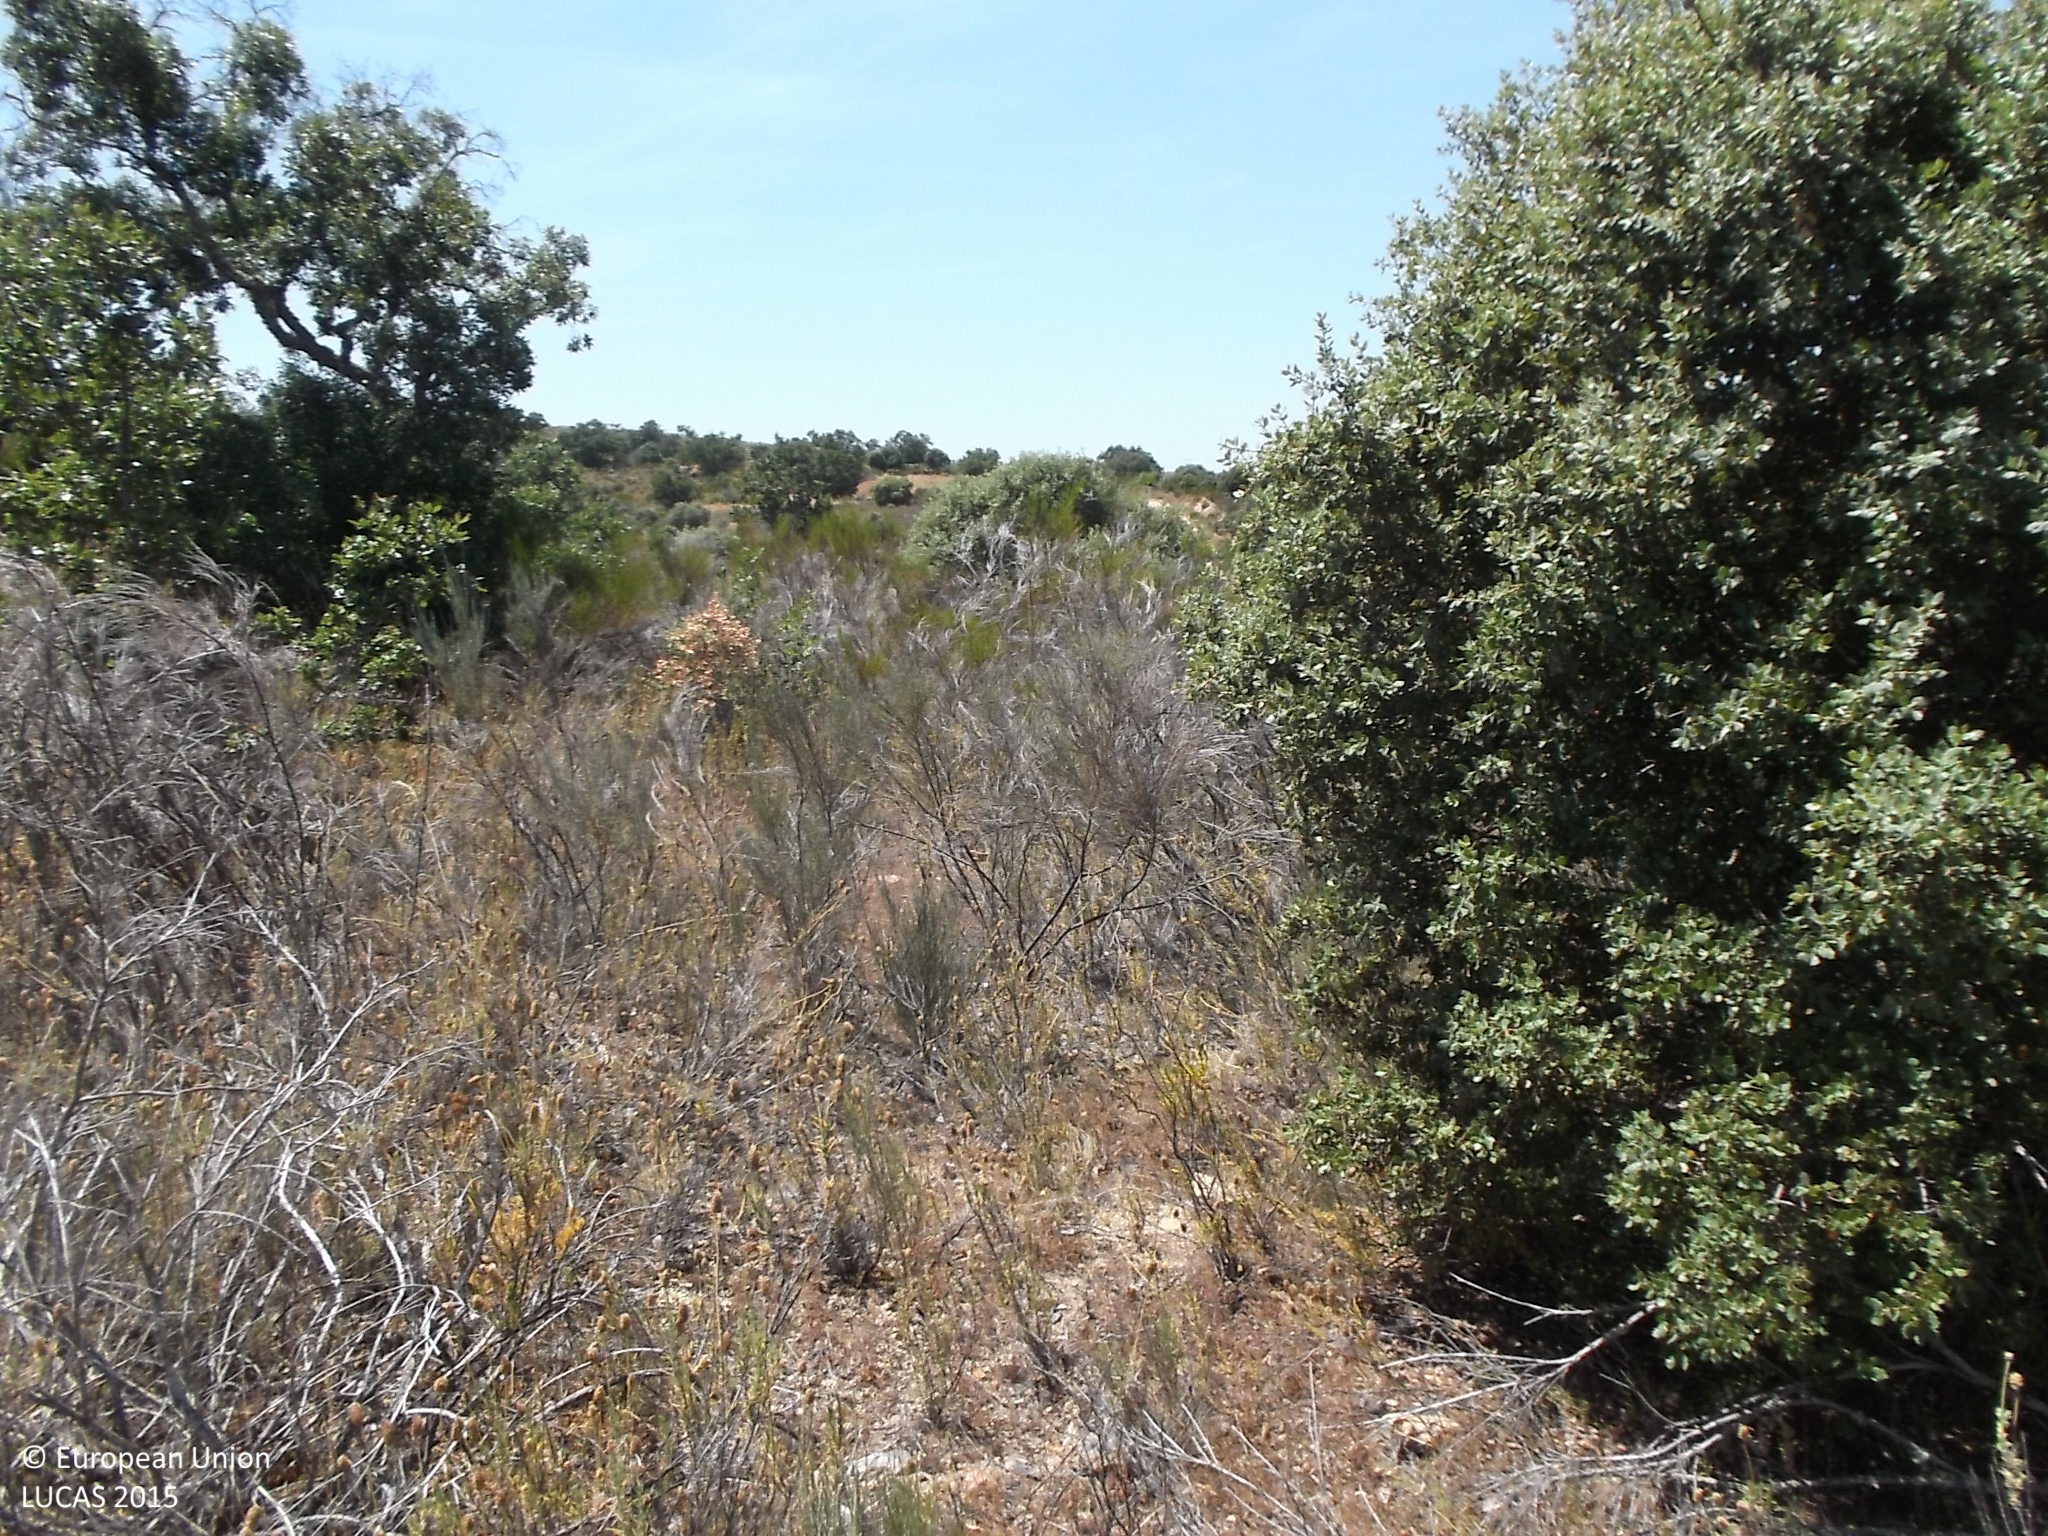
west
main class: Shrubland
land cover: Shrubland with sparse tree cover
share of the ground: > 75 %
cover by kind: shrubs 80 %, herbaceous plants 15 %, broadleaved forest trees 5 %
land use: Semi-natural and natural areas not in use
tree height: < 5 m
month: July
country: ES
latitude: 41.2712
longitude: -6.3917
